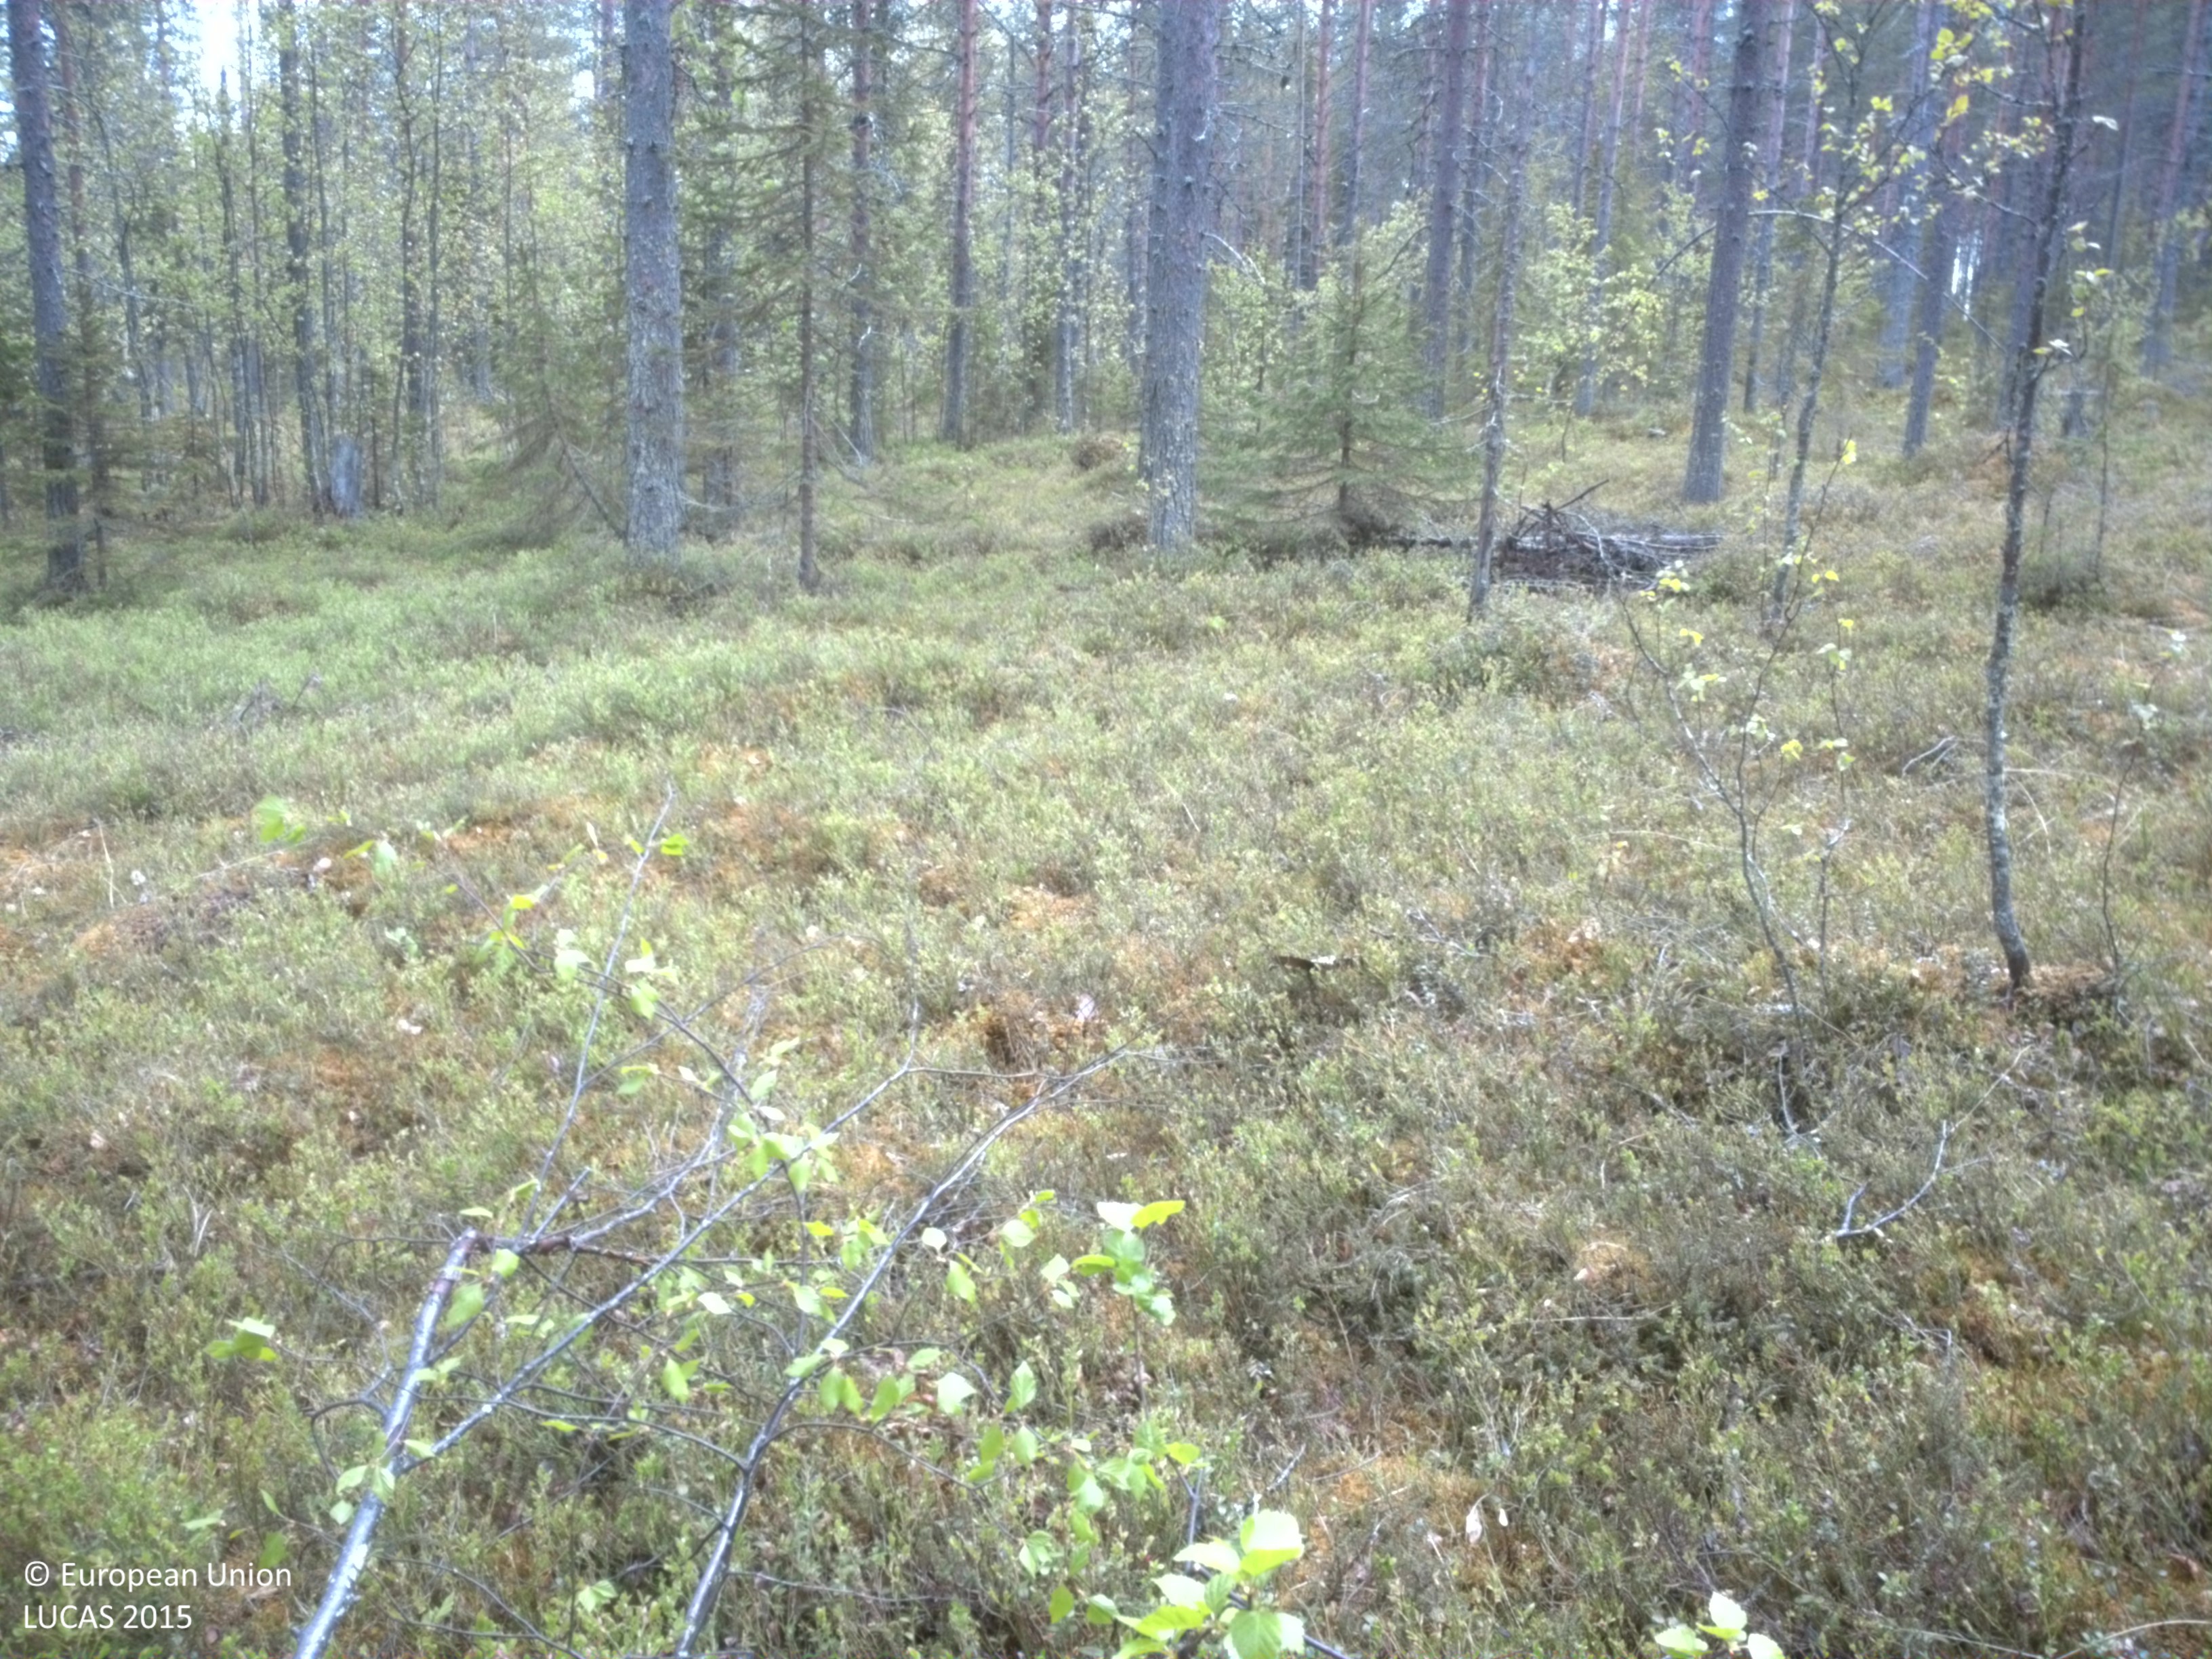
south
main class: Woodland
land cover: Pine dominated coniferous woodland
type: boreal forest
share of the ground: 10 - 25 %
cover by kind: herbaceous plants 65 %, coniferous forest trees 20 %, broadleaved forest trees 5 %, shrubs 5 %, lichens and mosses 5 %
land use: Forestry
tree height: > 5 m
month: June
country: SE
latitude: 66.7522
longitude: 22.4320
